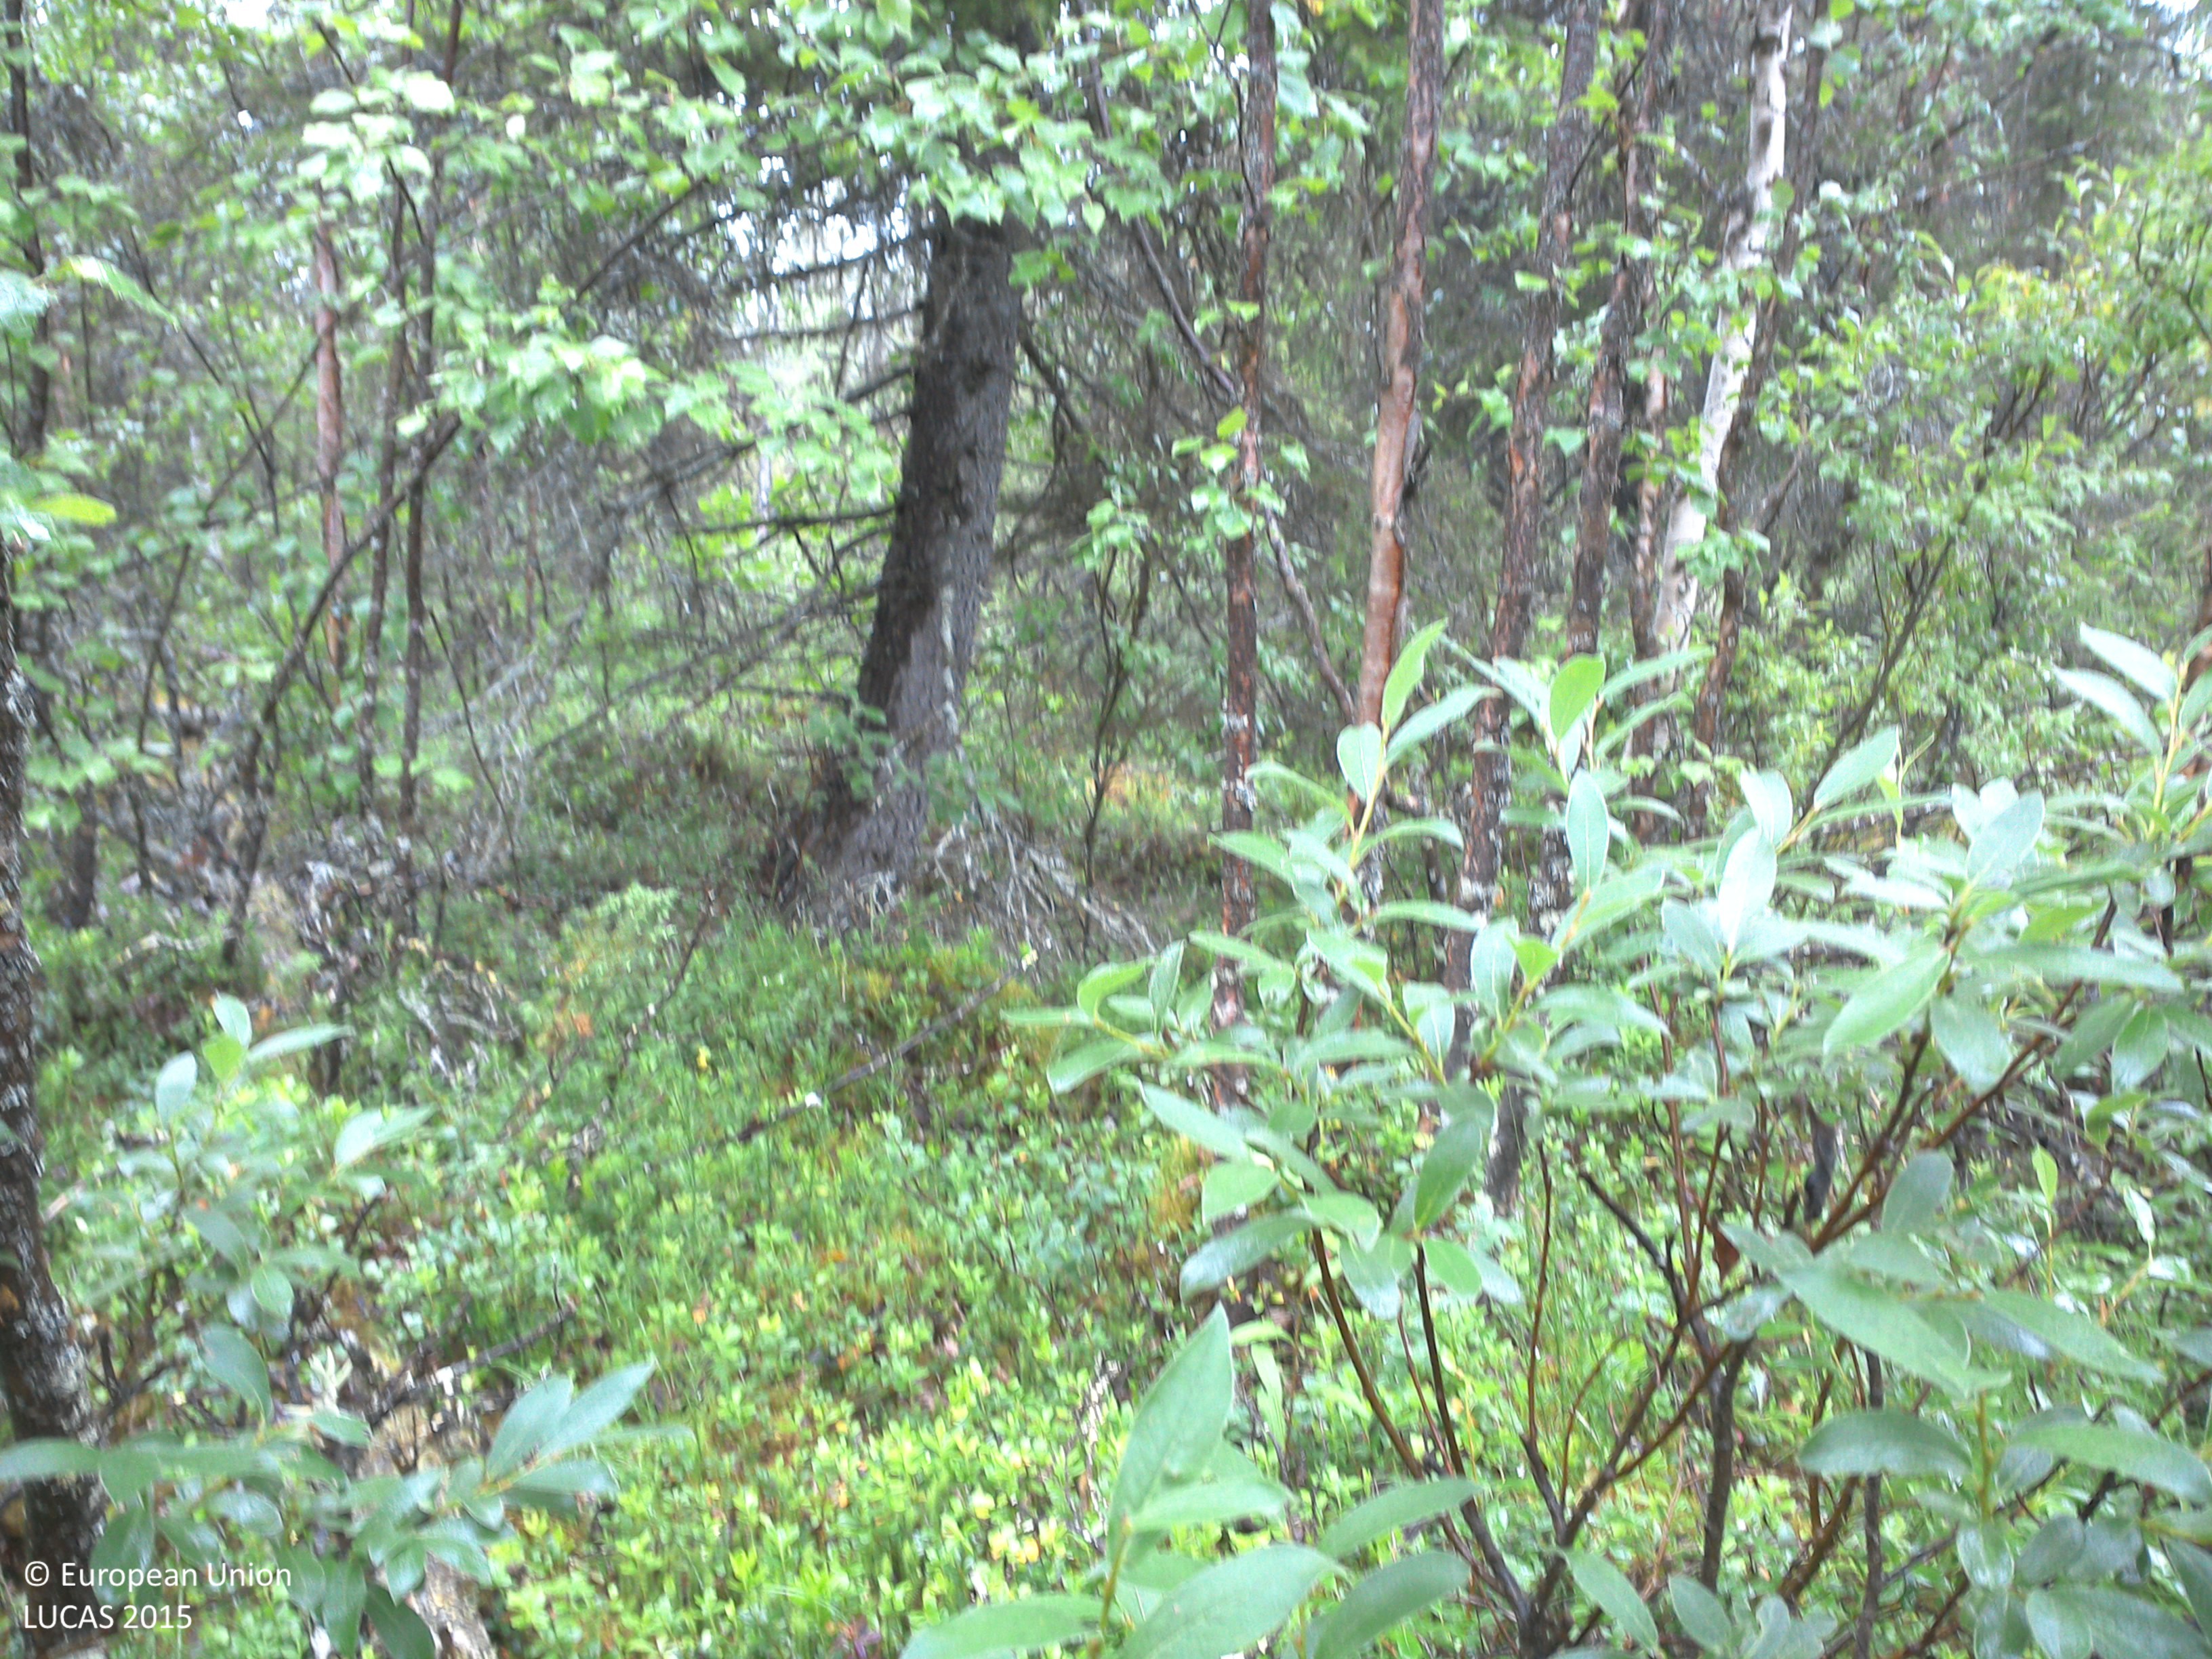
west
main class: Woodland
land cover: Spruce dominated mixed woodland
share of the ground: 25 - 50 %
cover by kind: shrubs 50 %, coniferous forest trees 25 %, broadleaved forest trees 15 %, lichens and mosses 10 %
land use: Forestry
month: July
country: SE
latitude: 67.6632
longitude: 21.4772
